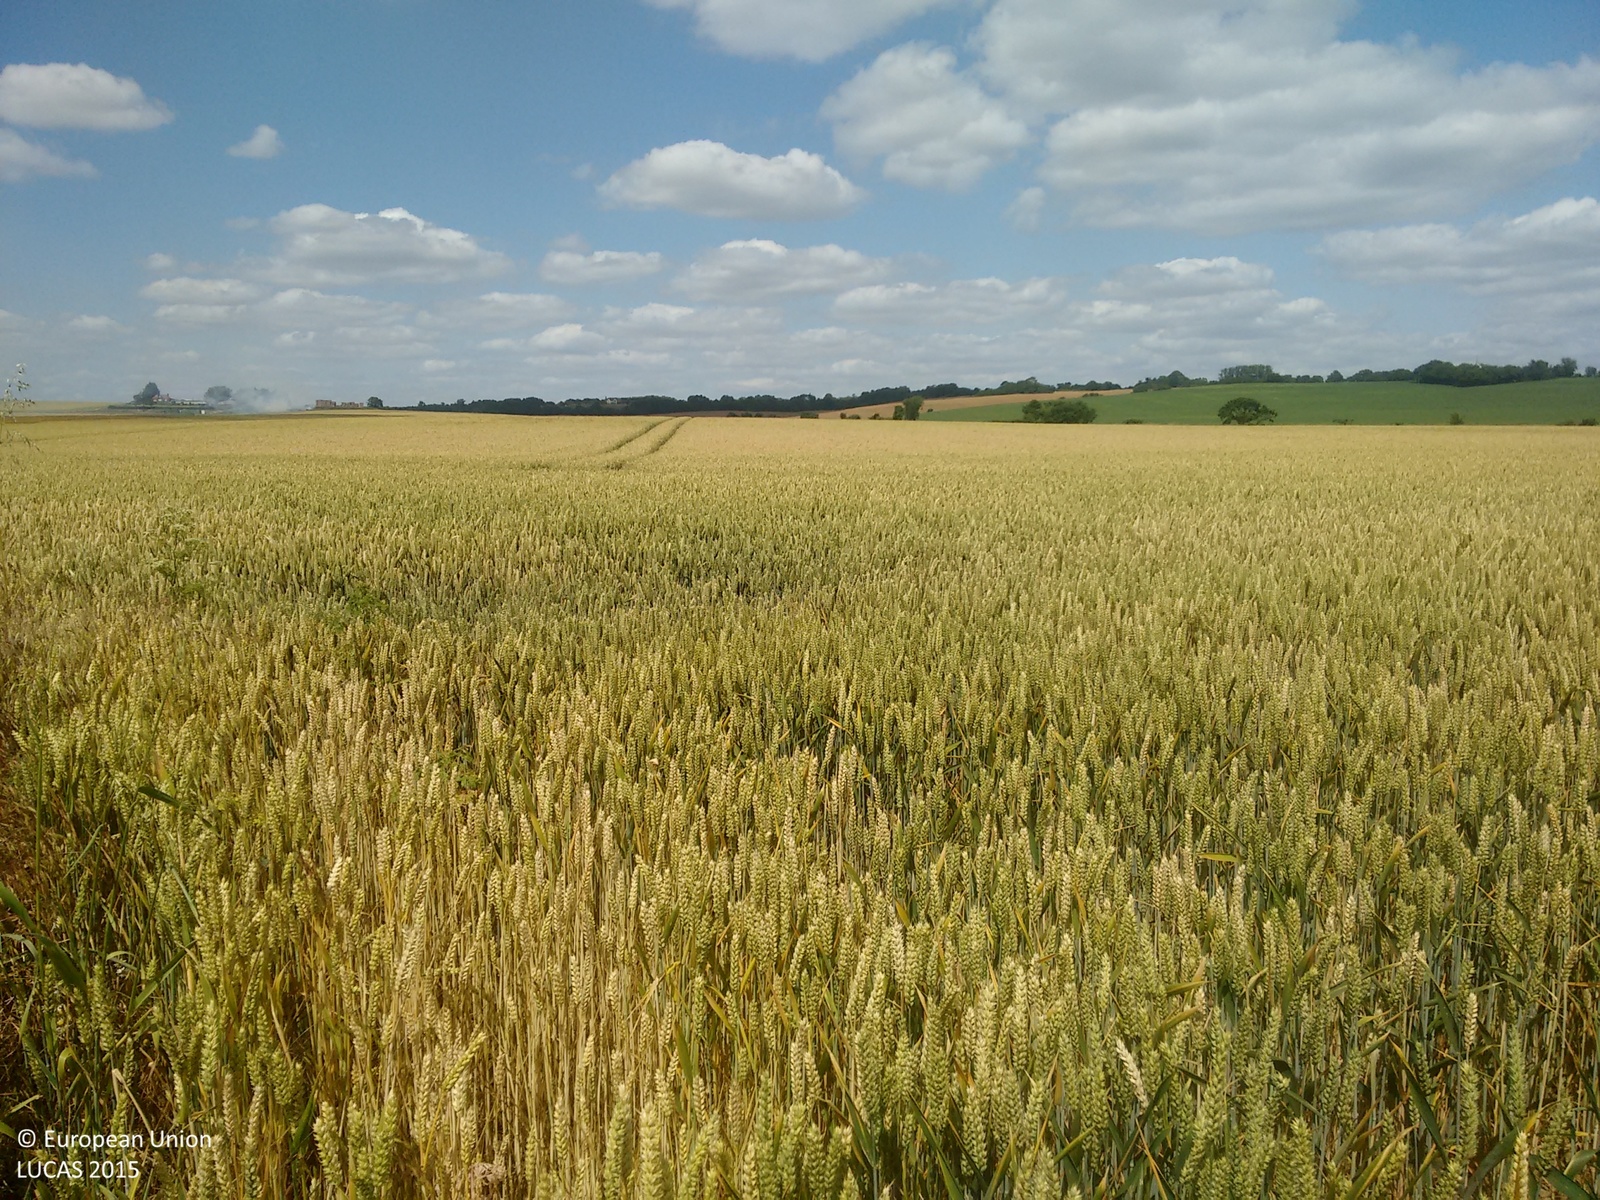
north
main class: Shrubland
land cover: Shrubland with sparse tree cover
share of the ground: > 75 %
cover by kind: shrubs 95 %, broadleaved forest trees 5 %
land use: Semi-natural and natural areas not in use
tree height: < 5 m
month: July
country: GB
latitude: 51.5894
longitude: 0.4016
